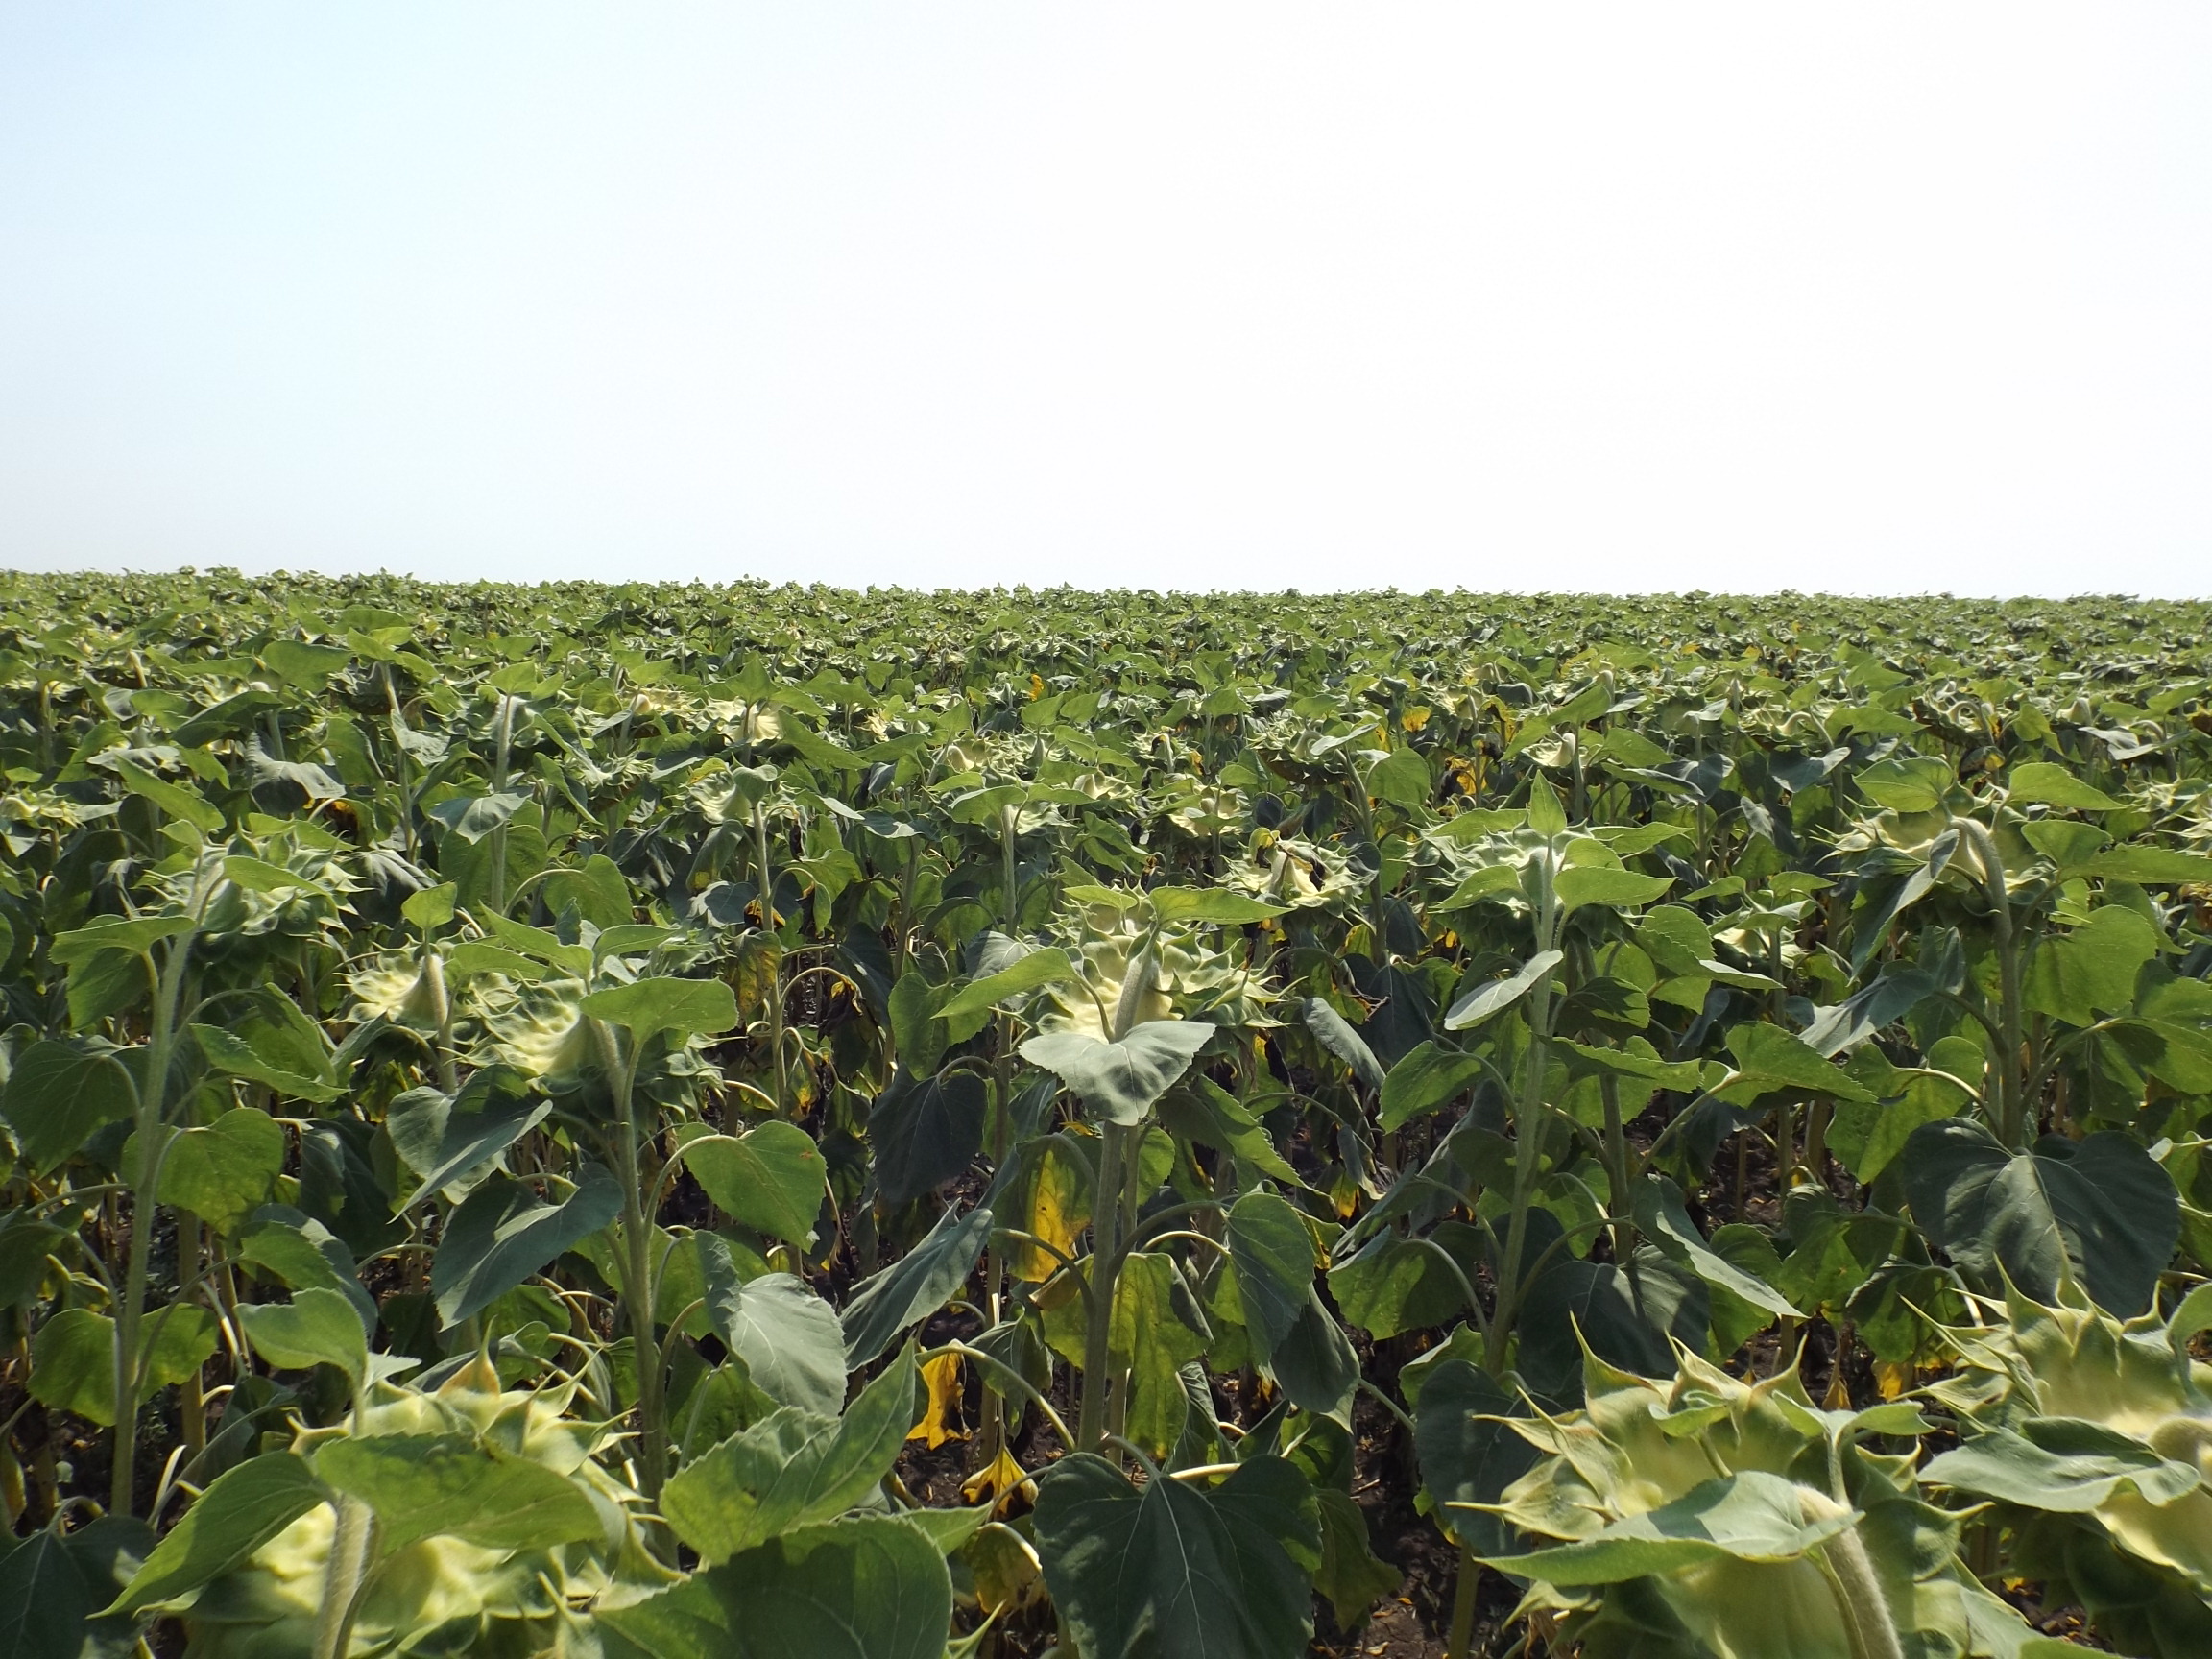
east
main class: Cropland
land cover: Sunflower
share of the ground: > 75 %
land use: Agriculture (excluding fallow land and kitchen gardens)
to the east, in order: Sunflower; Grass margins; Tracks; Grass margins; Maize
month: July
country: BG
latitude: 43.4881
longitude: 27.4276
